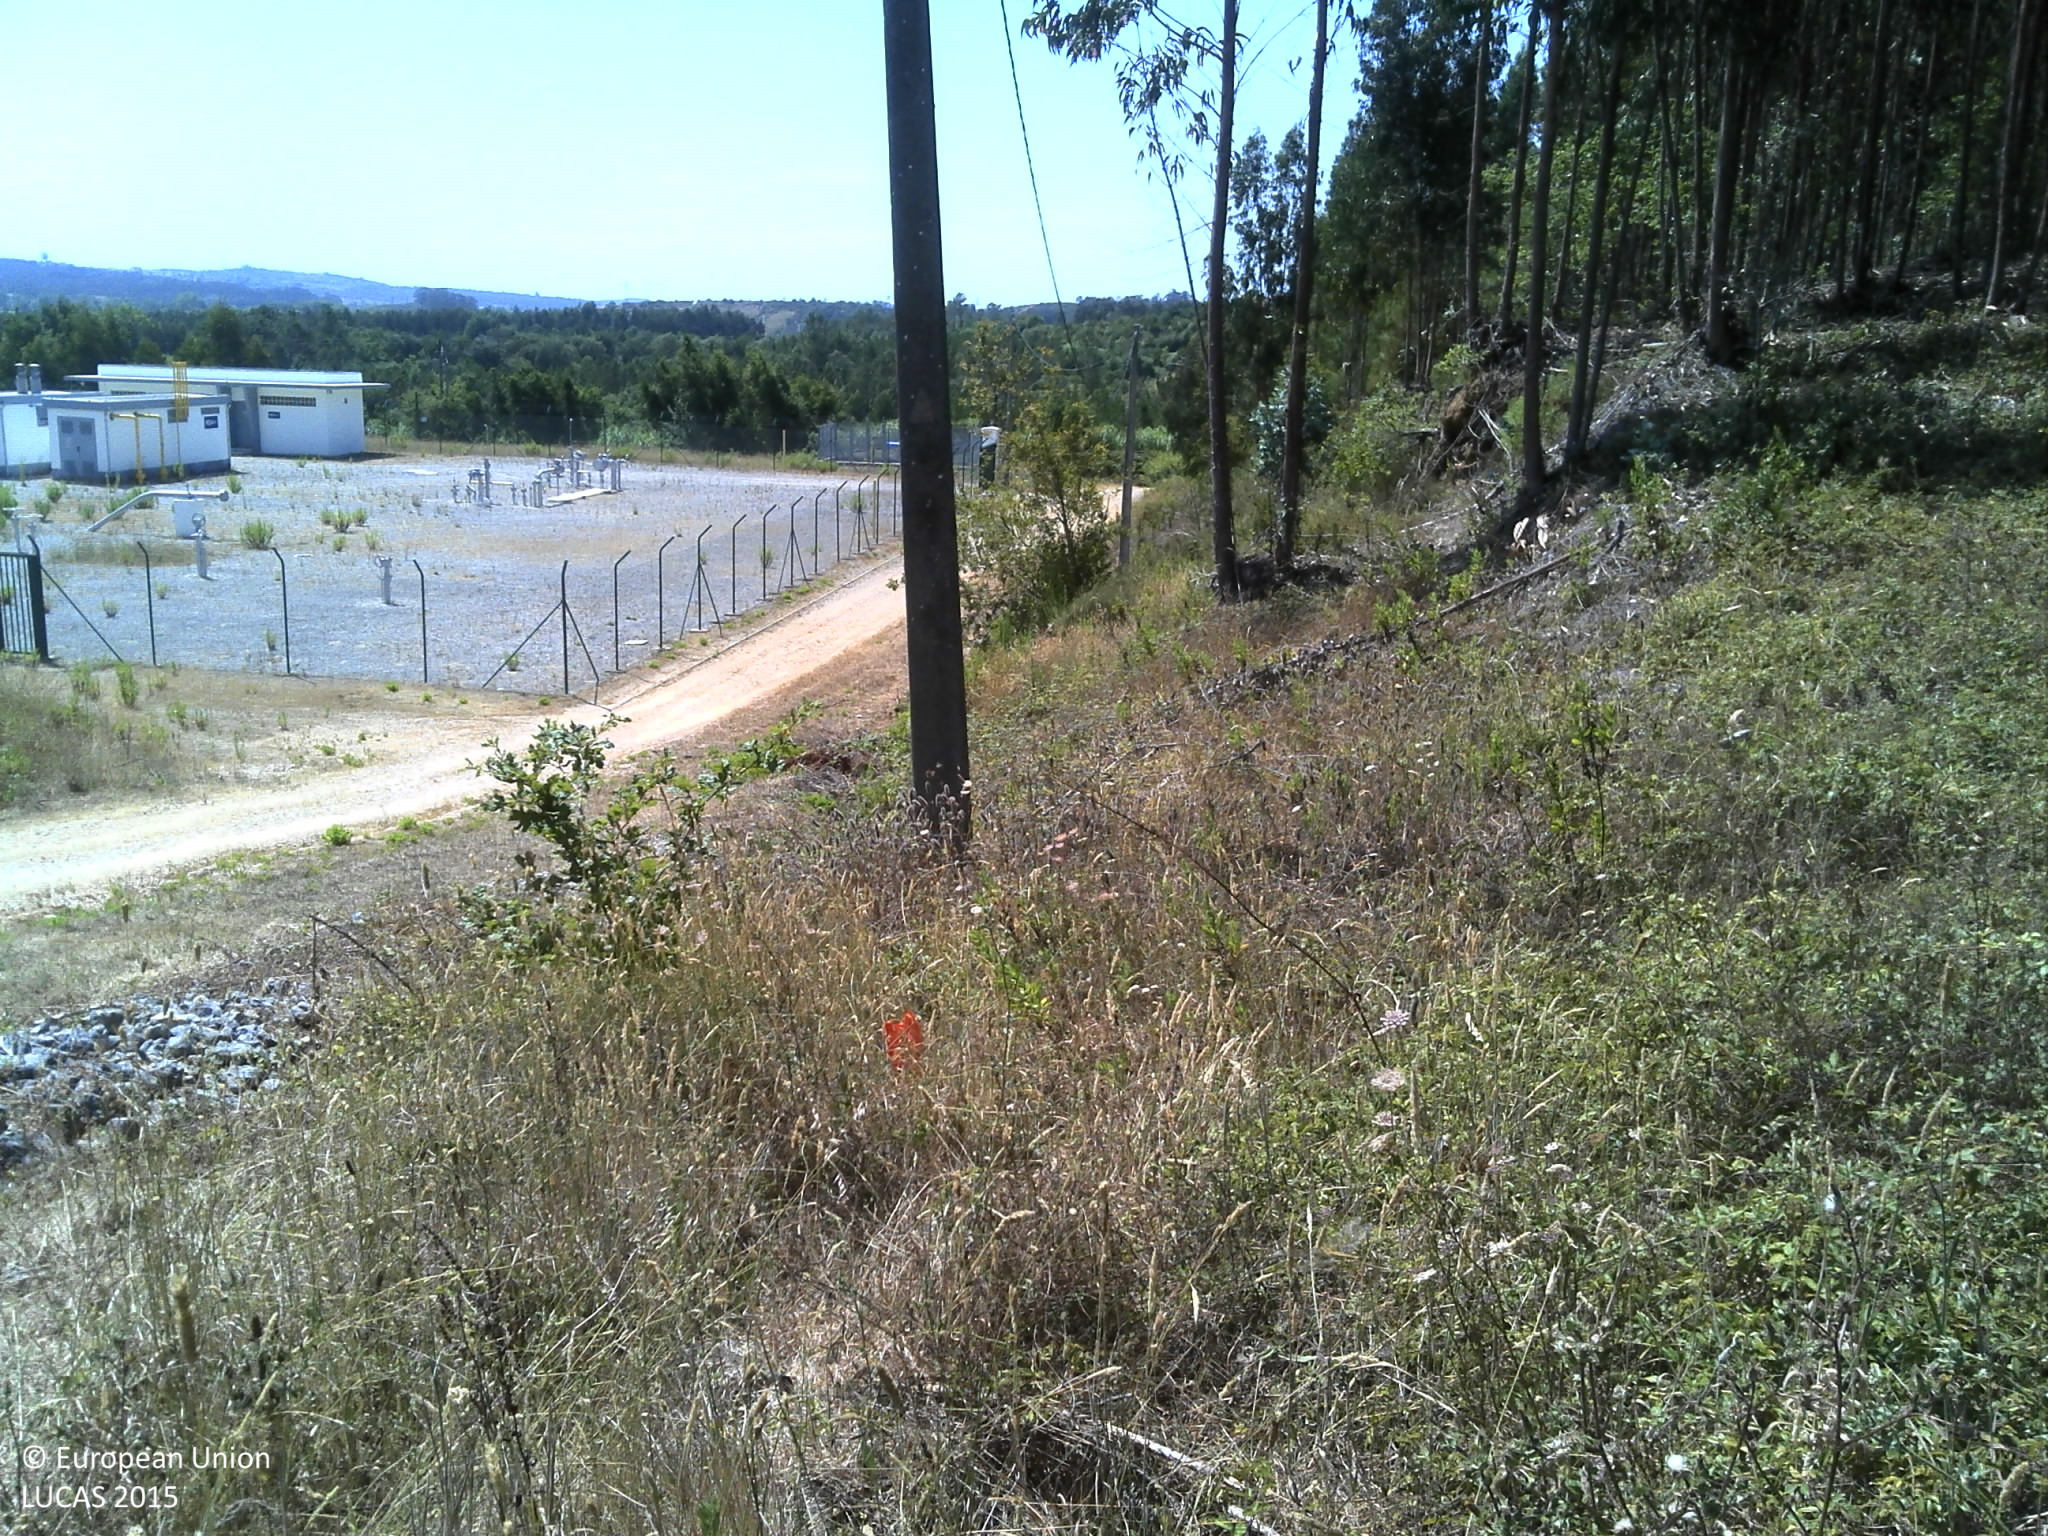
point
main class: Shrubland
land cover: Shrubland with sparse tree cover
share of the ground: 25 - 50 %
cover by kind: unconsolidated bare surface 60 %, shrubs 25 %, herbaceous plants 10 %, broadleaved forest trees 5 %
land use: Forestry
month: July
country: PT
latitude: 40.1458
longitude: -8.6468
